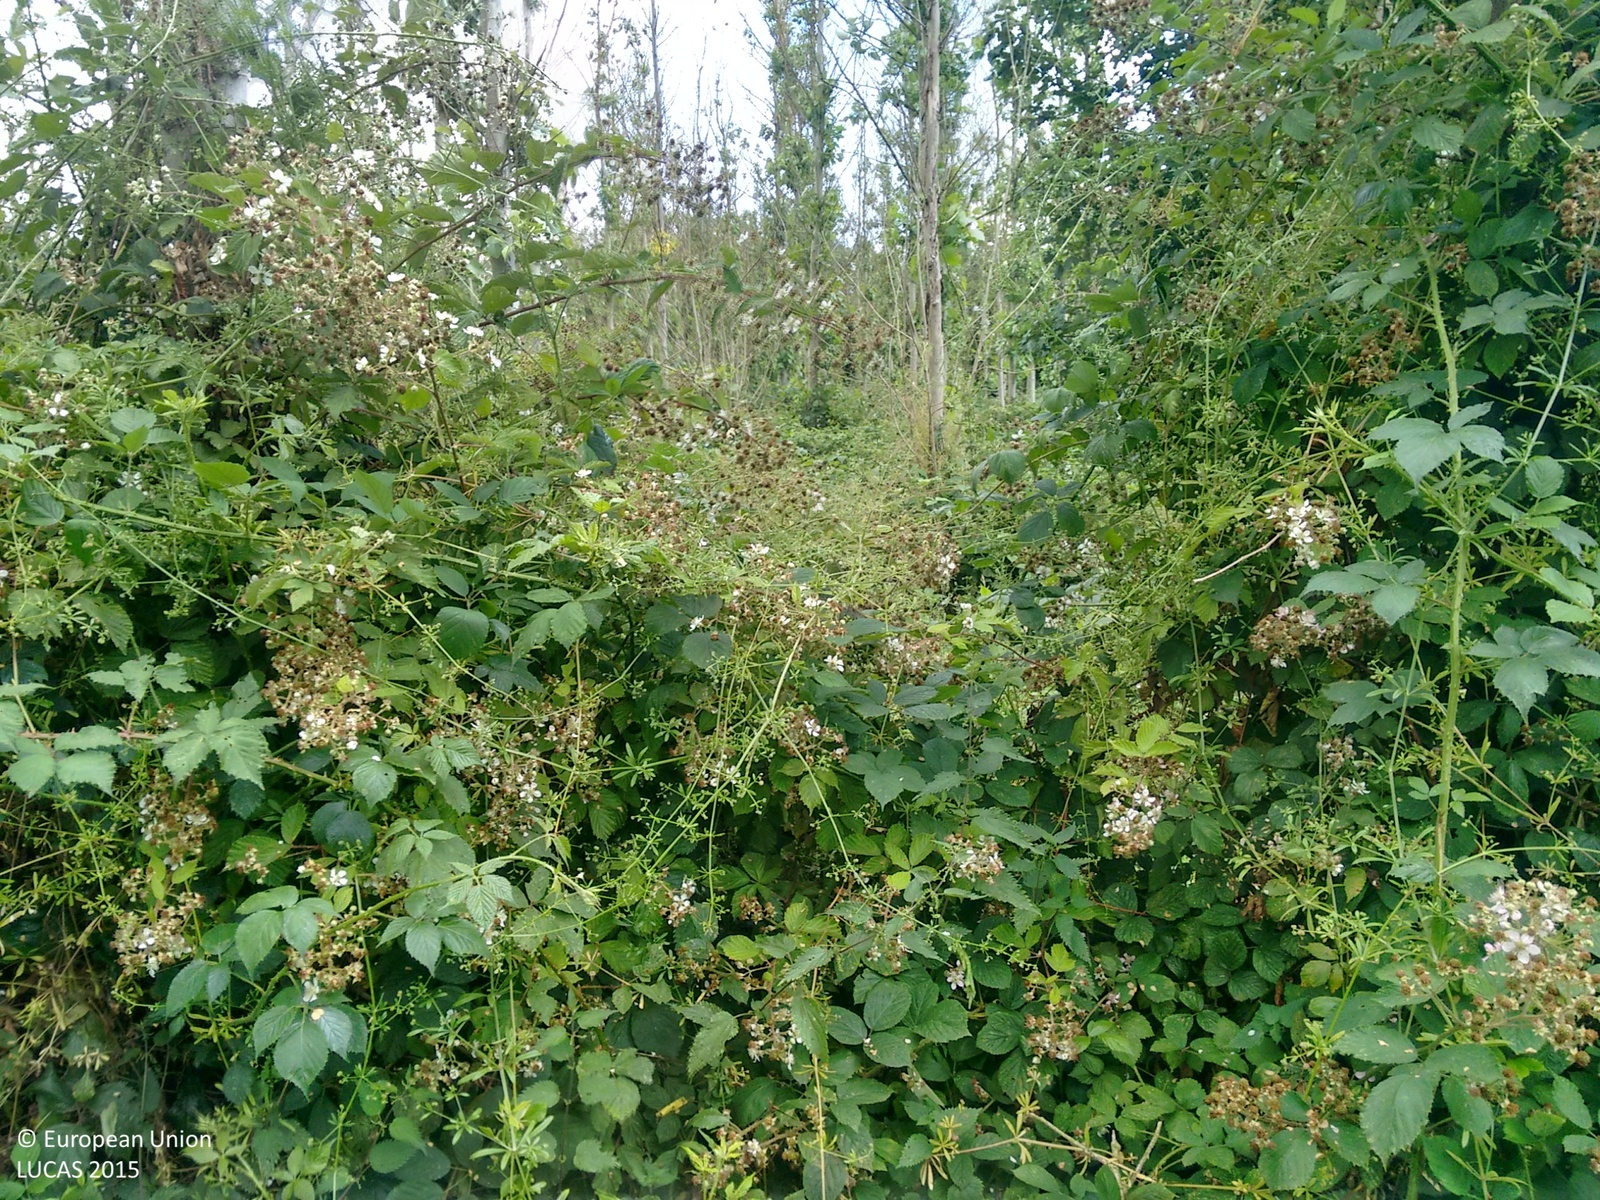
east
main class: Woodland
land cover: Broadleaved woodland
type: mesophytic deciduous forest
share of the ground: > 75 %
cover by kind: broadleaved forest trees 90 %, shrubs 10 %
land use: Forestry
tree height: > 5 m
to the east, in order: Broadleaved woodland; Abandoned hedges; Fences; Grassland without tree/shrub cover
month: July
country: GB
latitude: 52.6050
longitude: -1.7941
